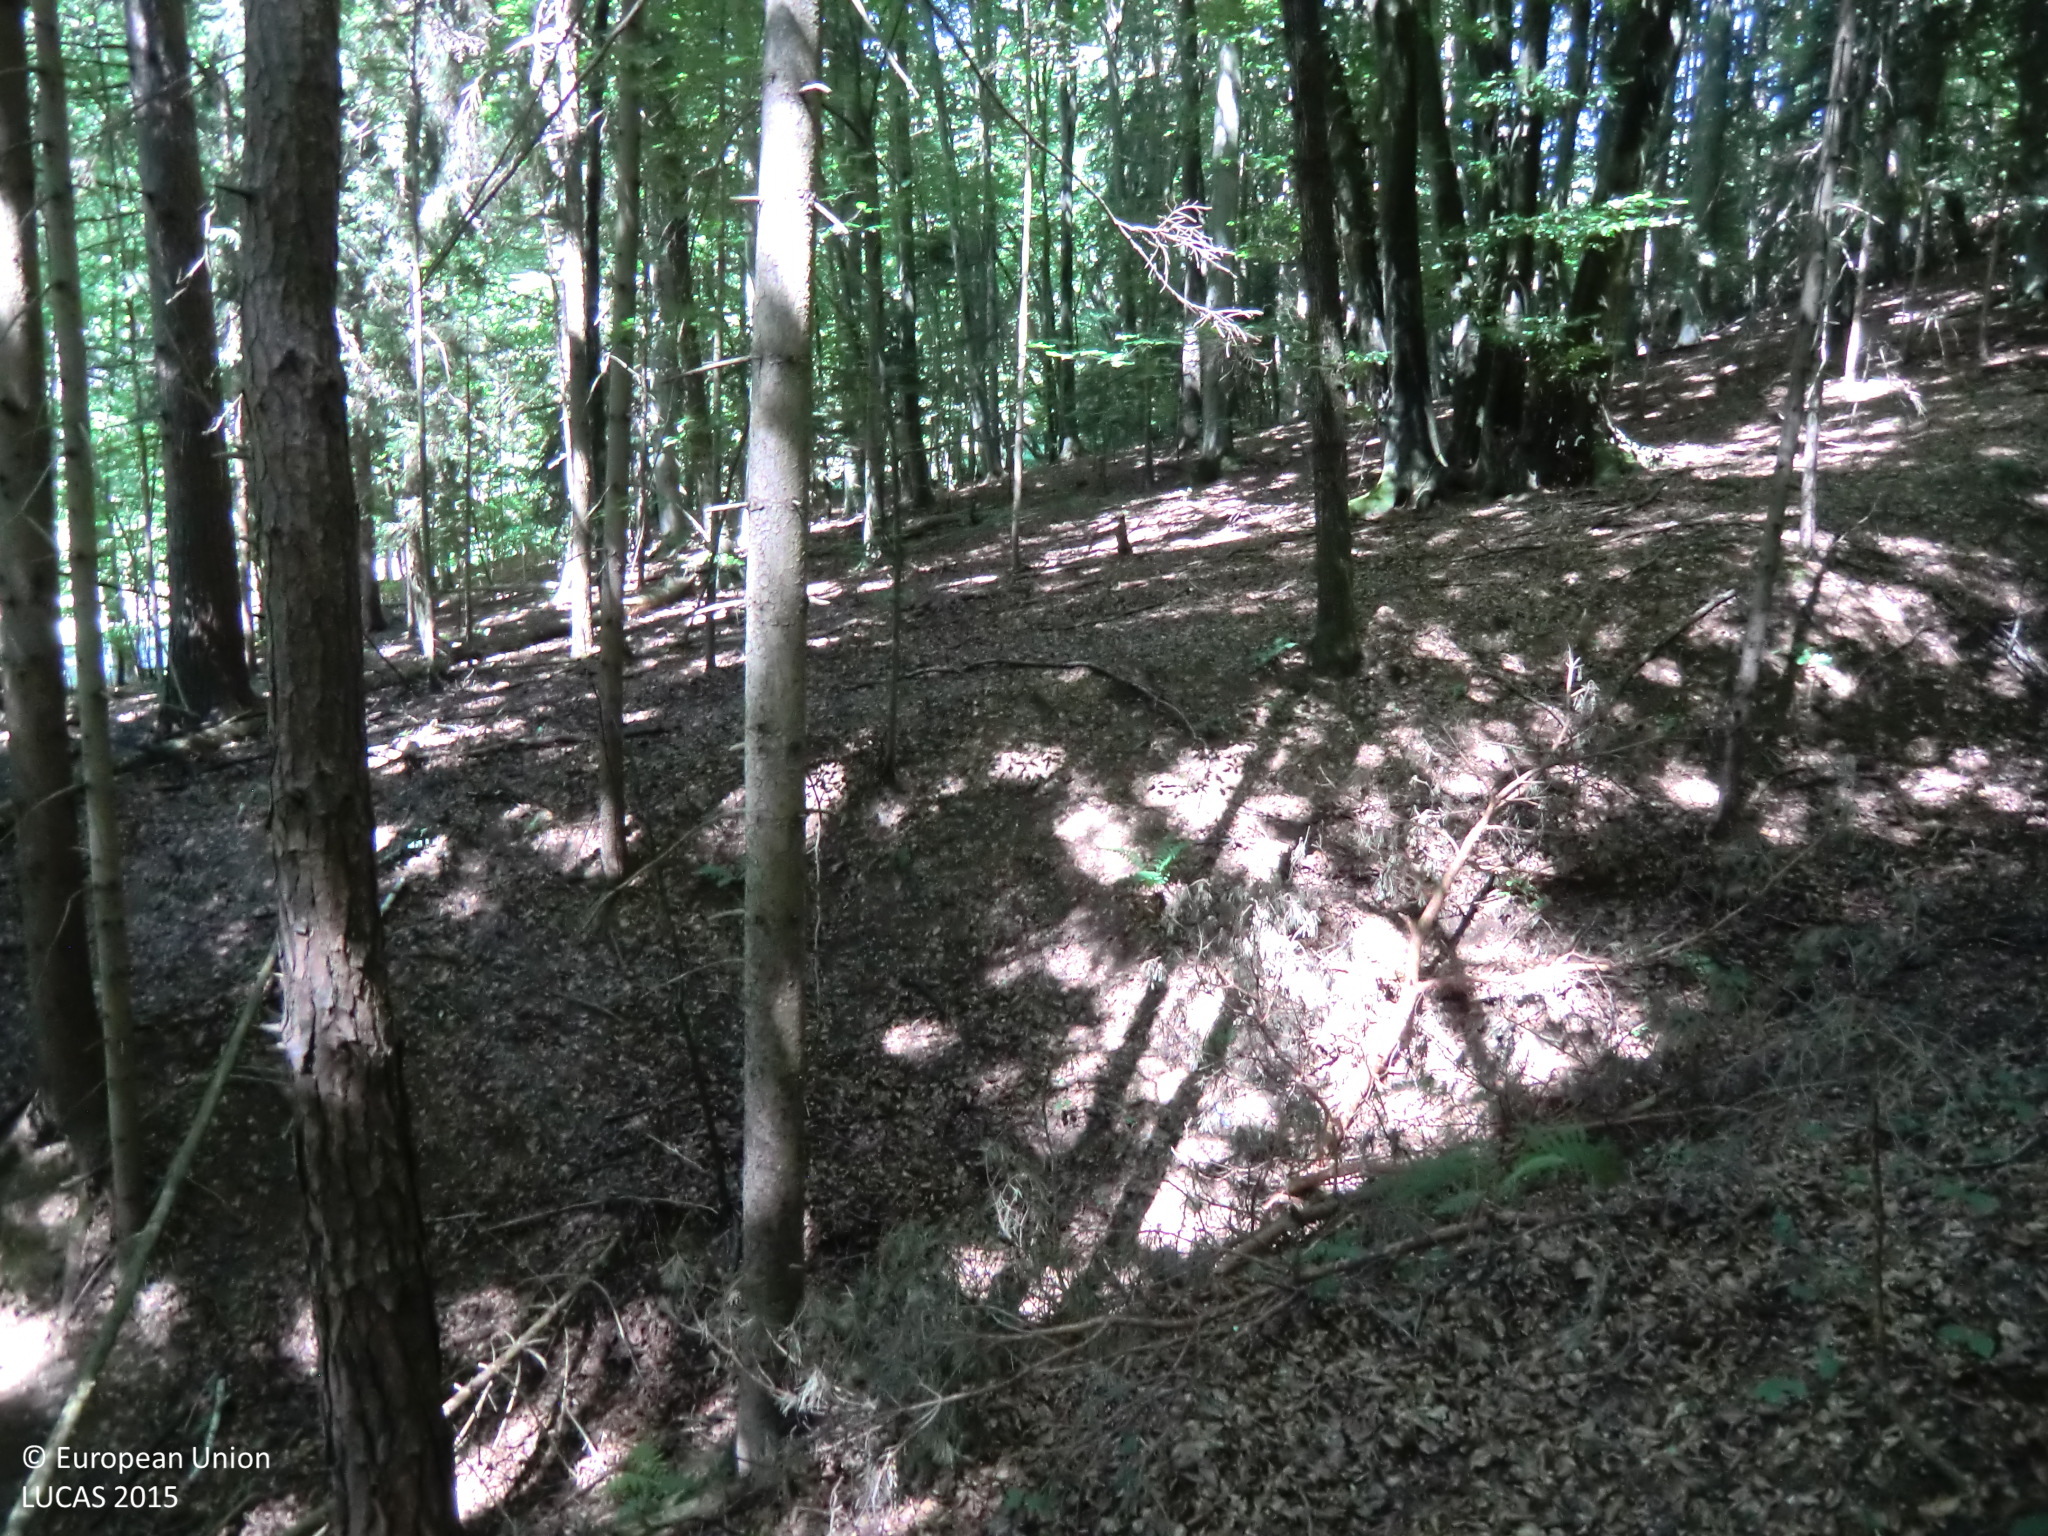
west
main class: Woodland
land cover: Spruce dominated mixed woodland
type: hemiboreal forest and nemoral coniferous forest and mixed broadleaved-coniferous forest
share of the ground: > 75 %
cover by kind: coniferous forest trees 45 %, broadleaved forest trees 40 %, unconsolidated bare surface 10 %, herbaceous plants 5 %
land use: Forestry
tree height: > 5 m
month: July
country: AT
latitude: 47.0352
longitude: 15.5930
